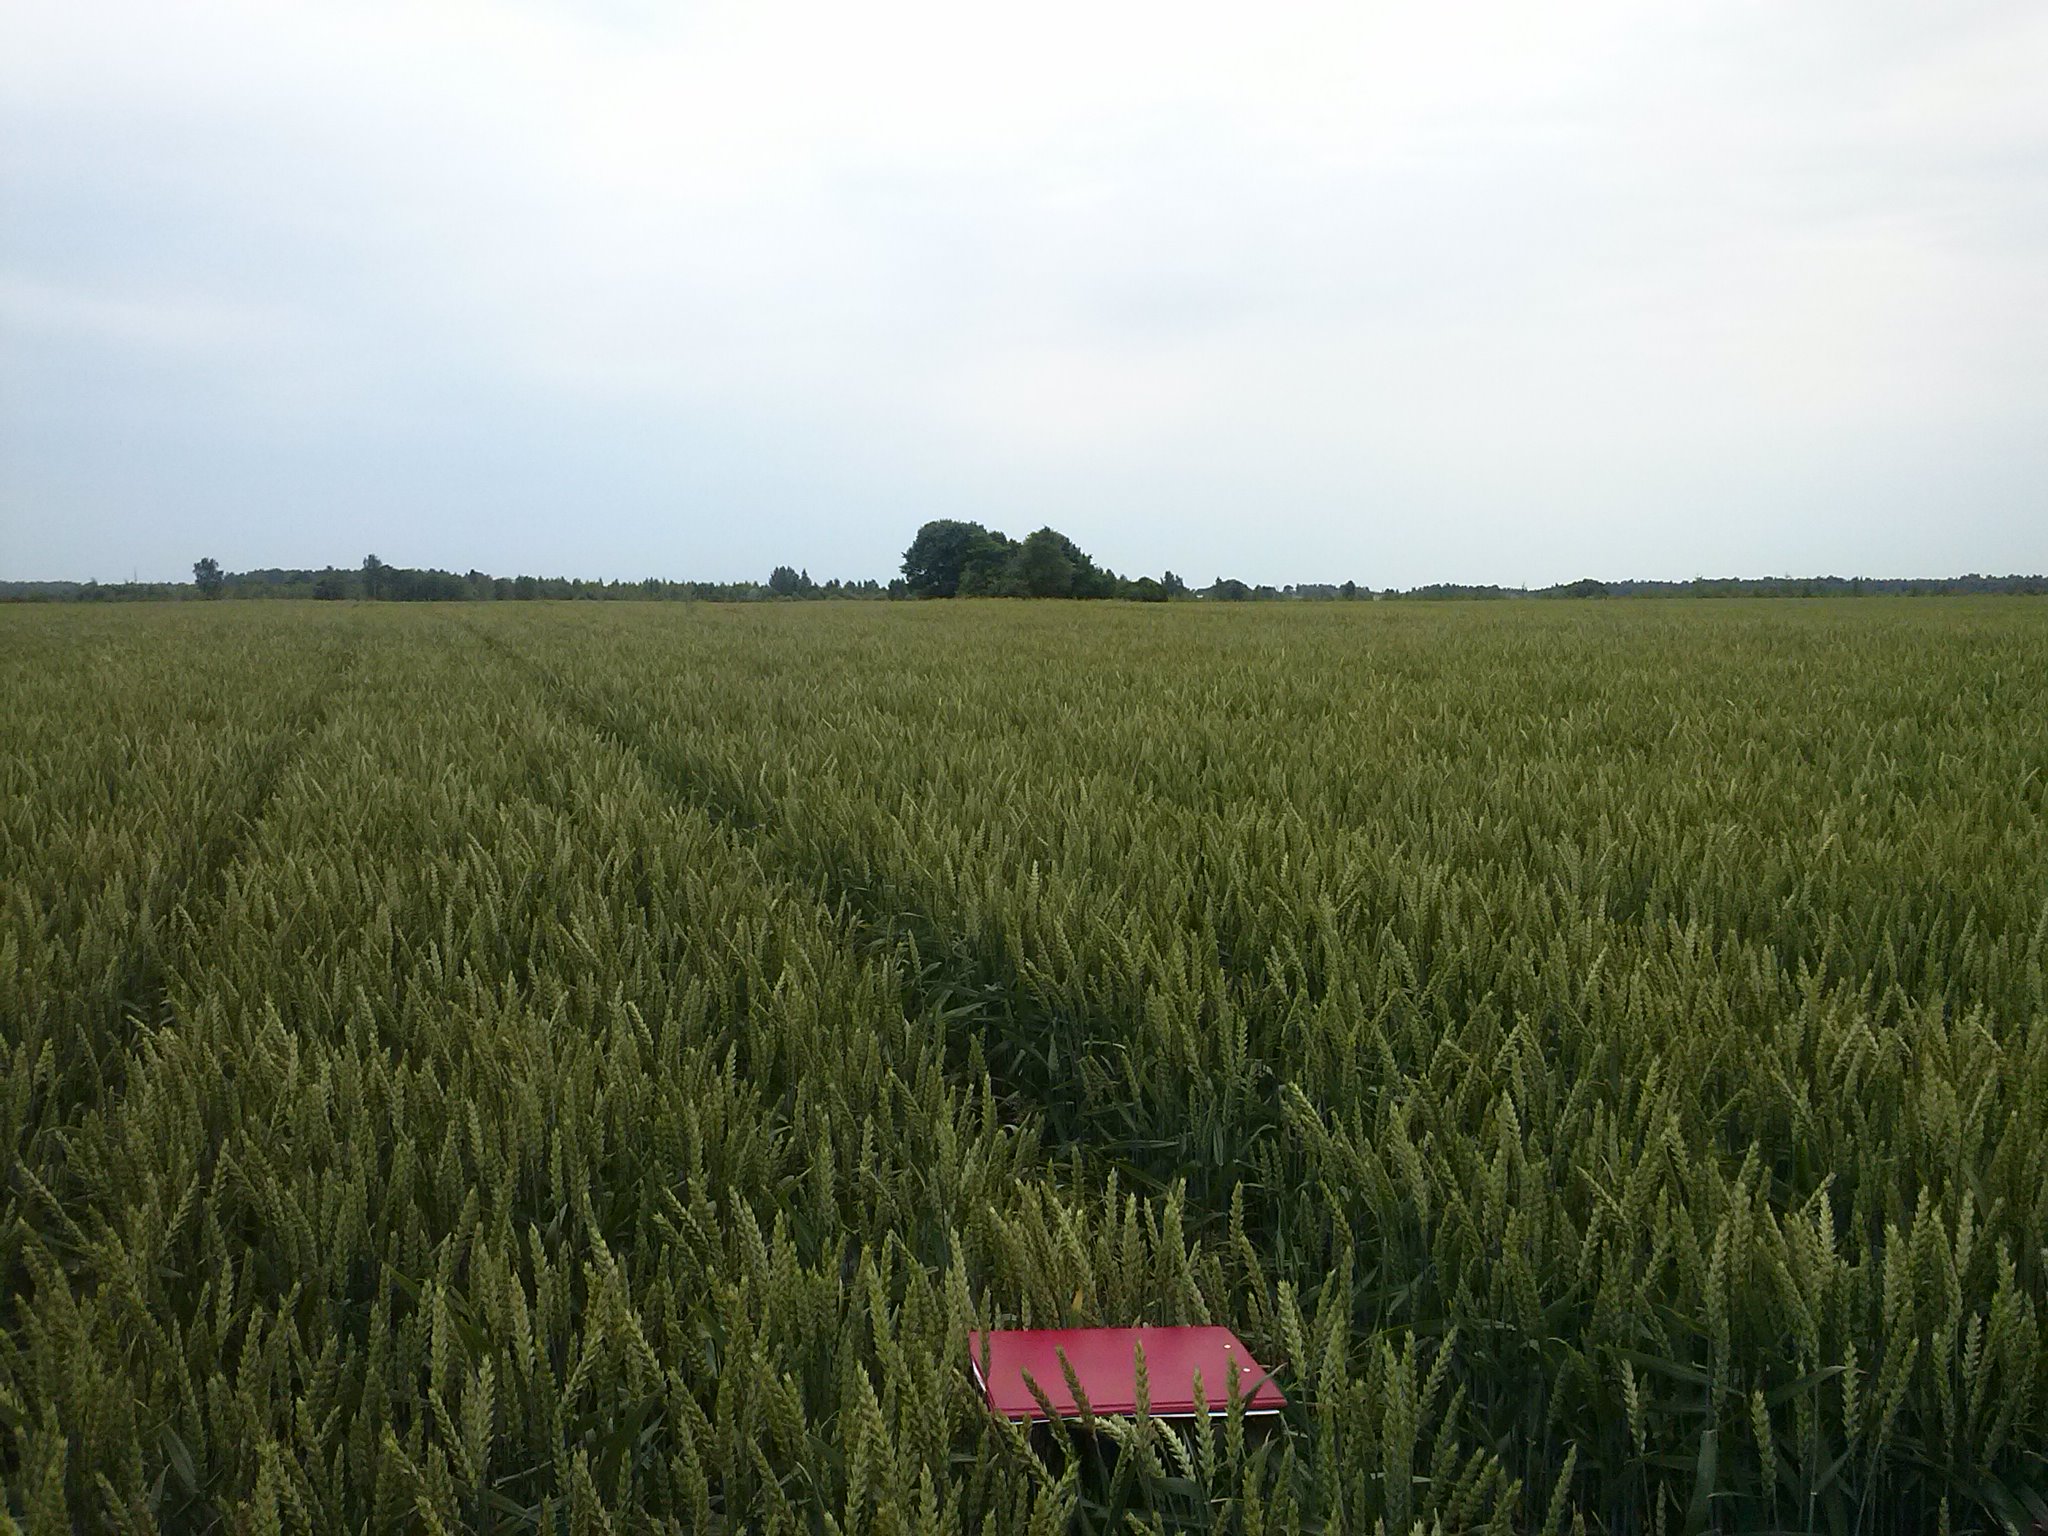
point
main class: Cropland
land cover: Common wheat
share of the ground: > 75 %
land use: Agriculture (excluding fallow land and kitchen gardens)
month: July
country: LV
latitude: 56.7871
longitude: 27.4456
